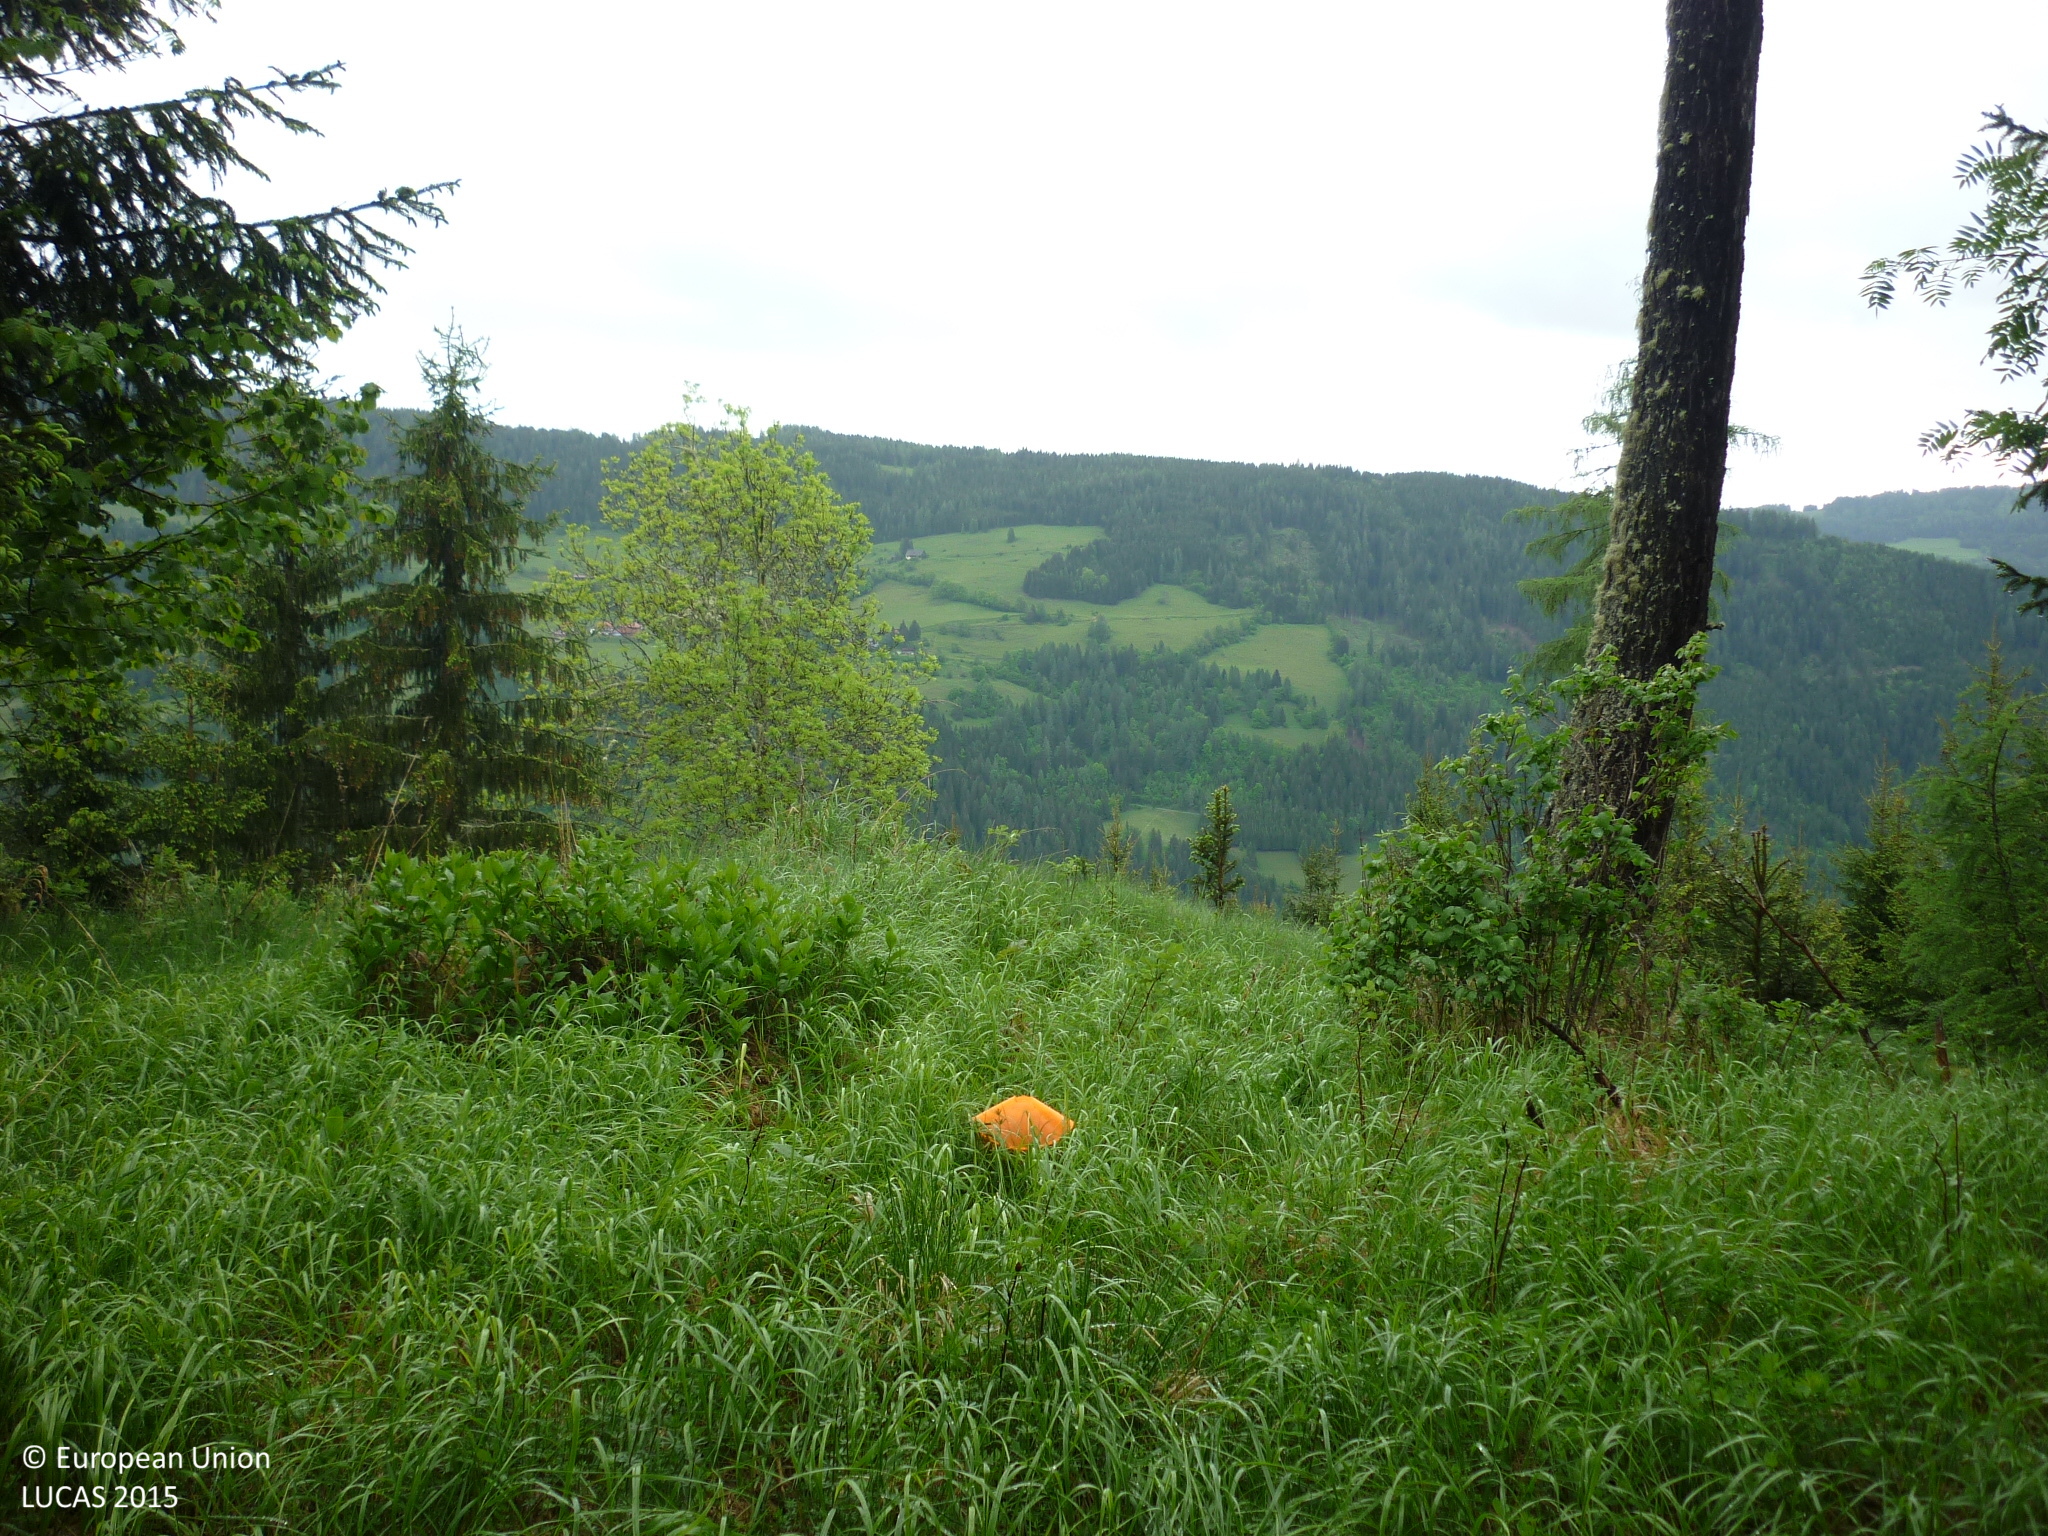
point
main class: Grassland
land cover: Grassland with sparse tree/shrub cover
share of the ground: > 75 %
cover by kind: herbaceous plants 85 %, shrubs 10 %, coniferous forest trees 5 %
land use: Forestry
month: May
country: AT
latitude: 47.1002
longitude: 14.1485
